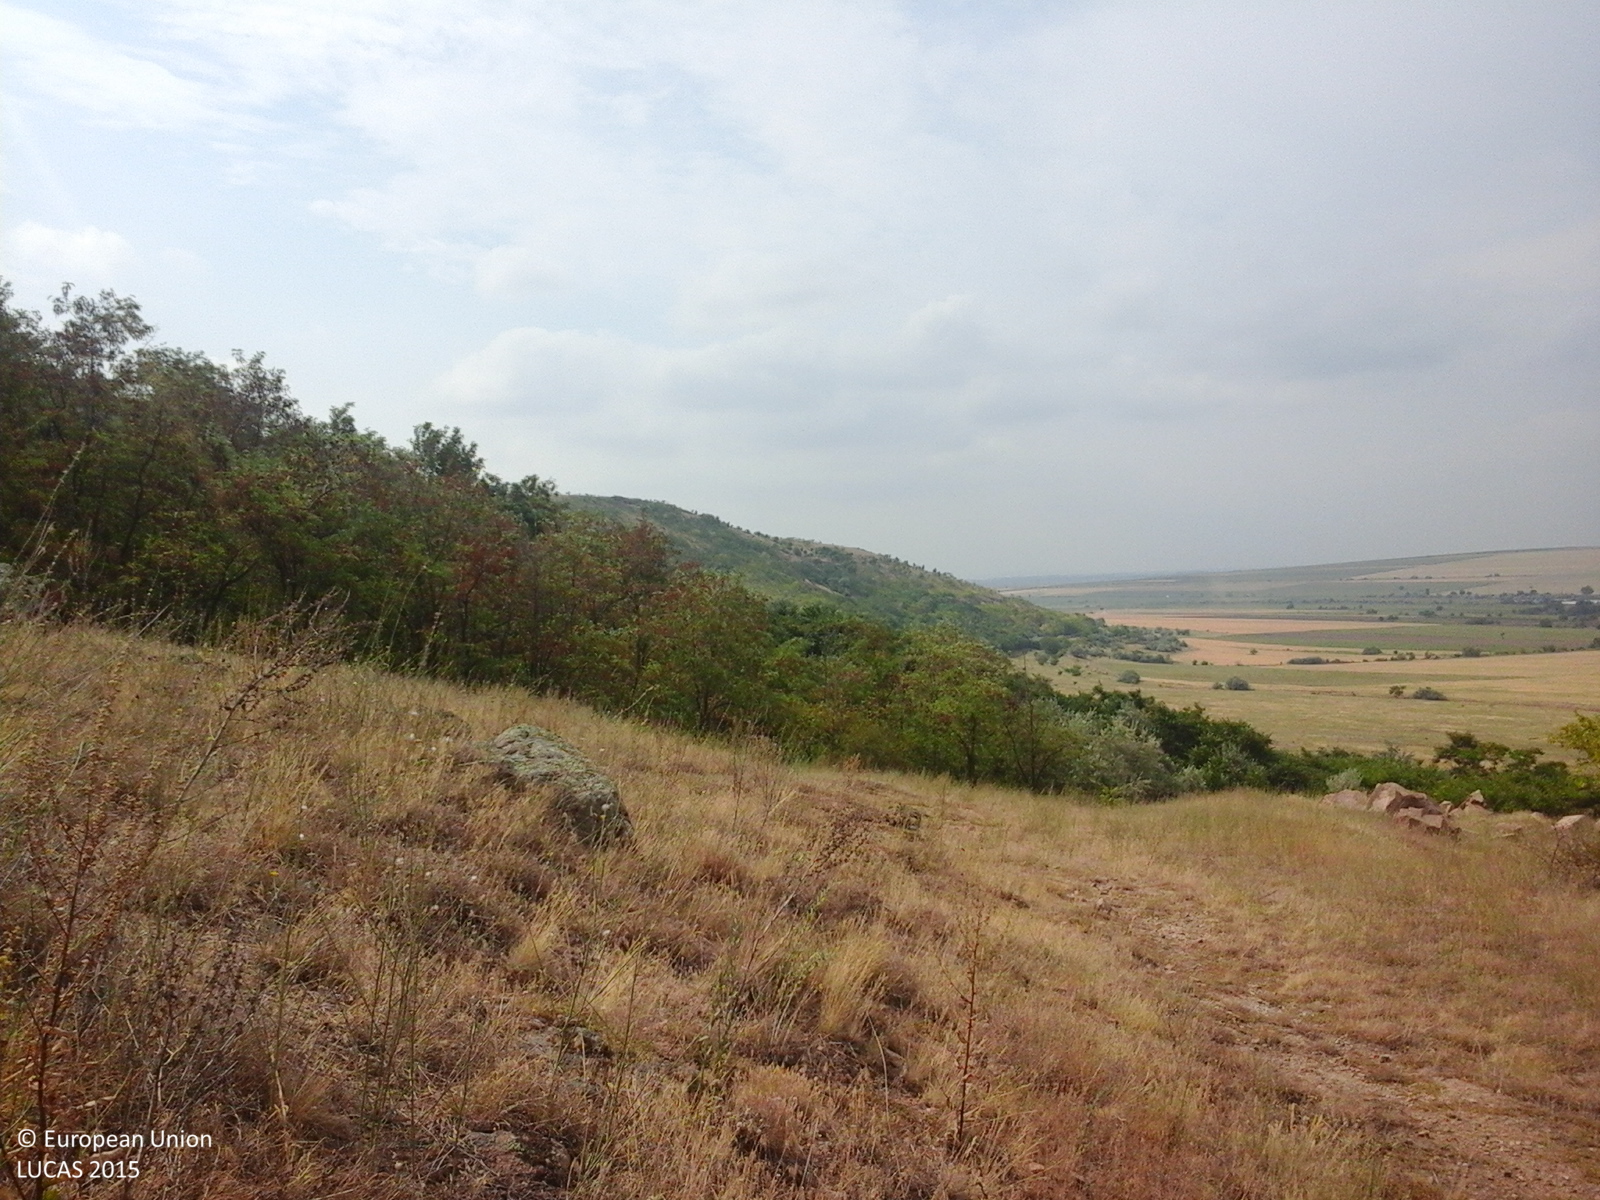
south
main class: Grassland
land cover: Grassland without tree/shrub cover
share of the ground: > 75 %
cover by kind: herbaceous plants 100 %
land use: Agriculture (excluding fallow land and kitchen gardens)
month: July
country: RO
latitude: 45.2344
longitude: 28.1964
